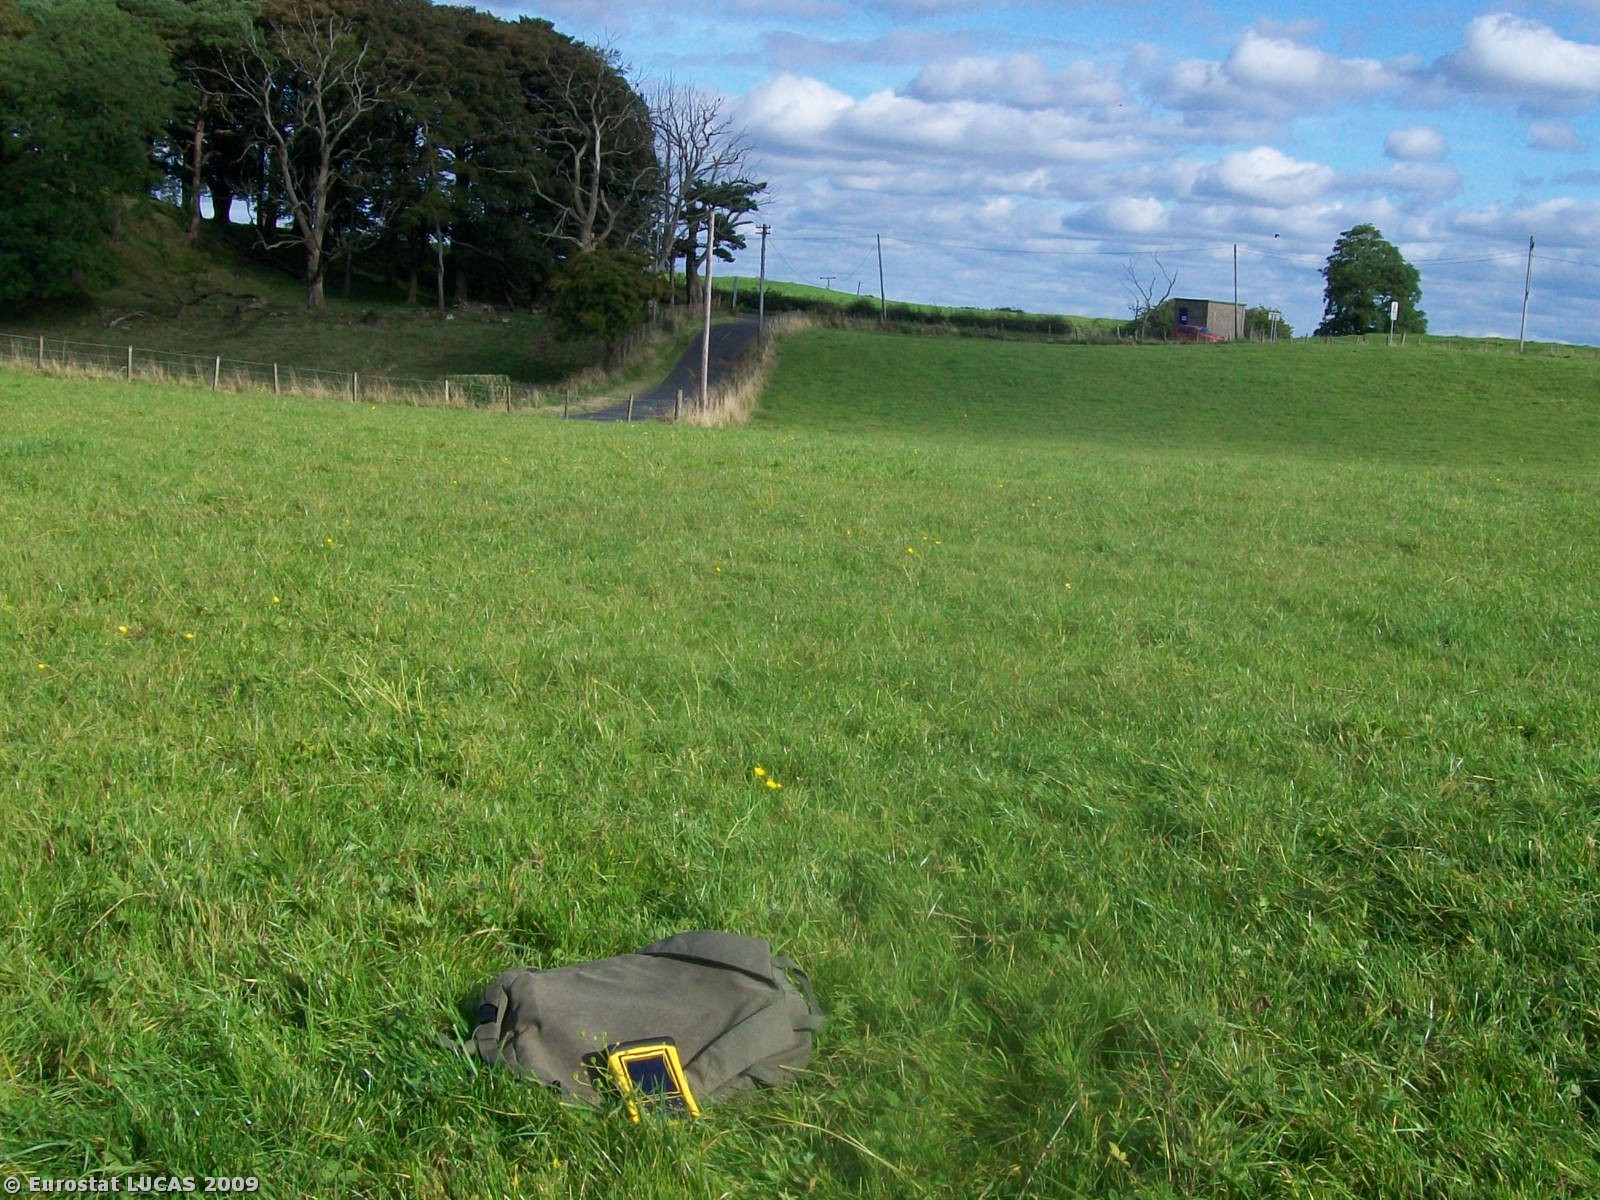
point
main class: Grassland
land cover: Grassland without tree/shrub cover
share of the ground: < 10 %
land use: Agriculture (excluding fallow land and kitchen gardens)
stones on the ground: 10 - 25 %
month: September
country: GB
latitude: 55.7761
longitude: -4.3646
